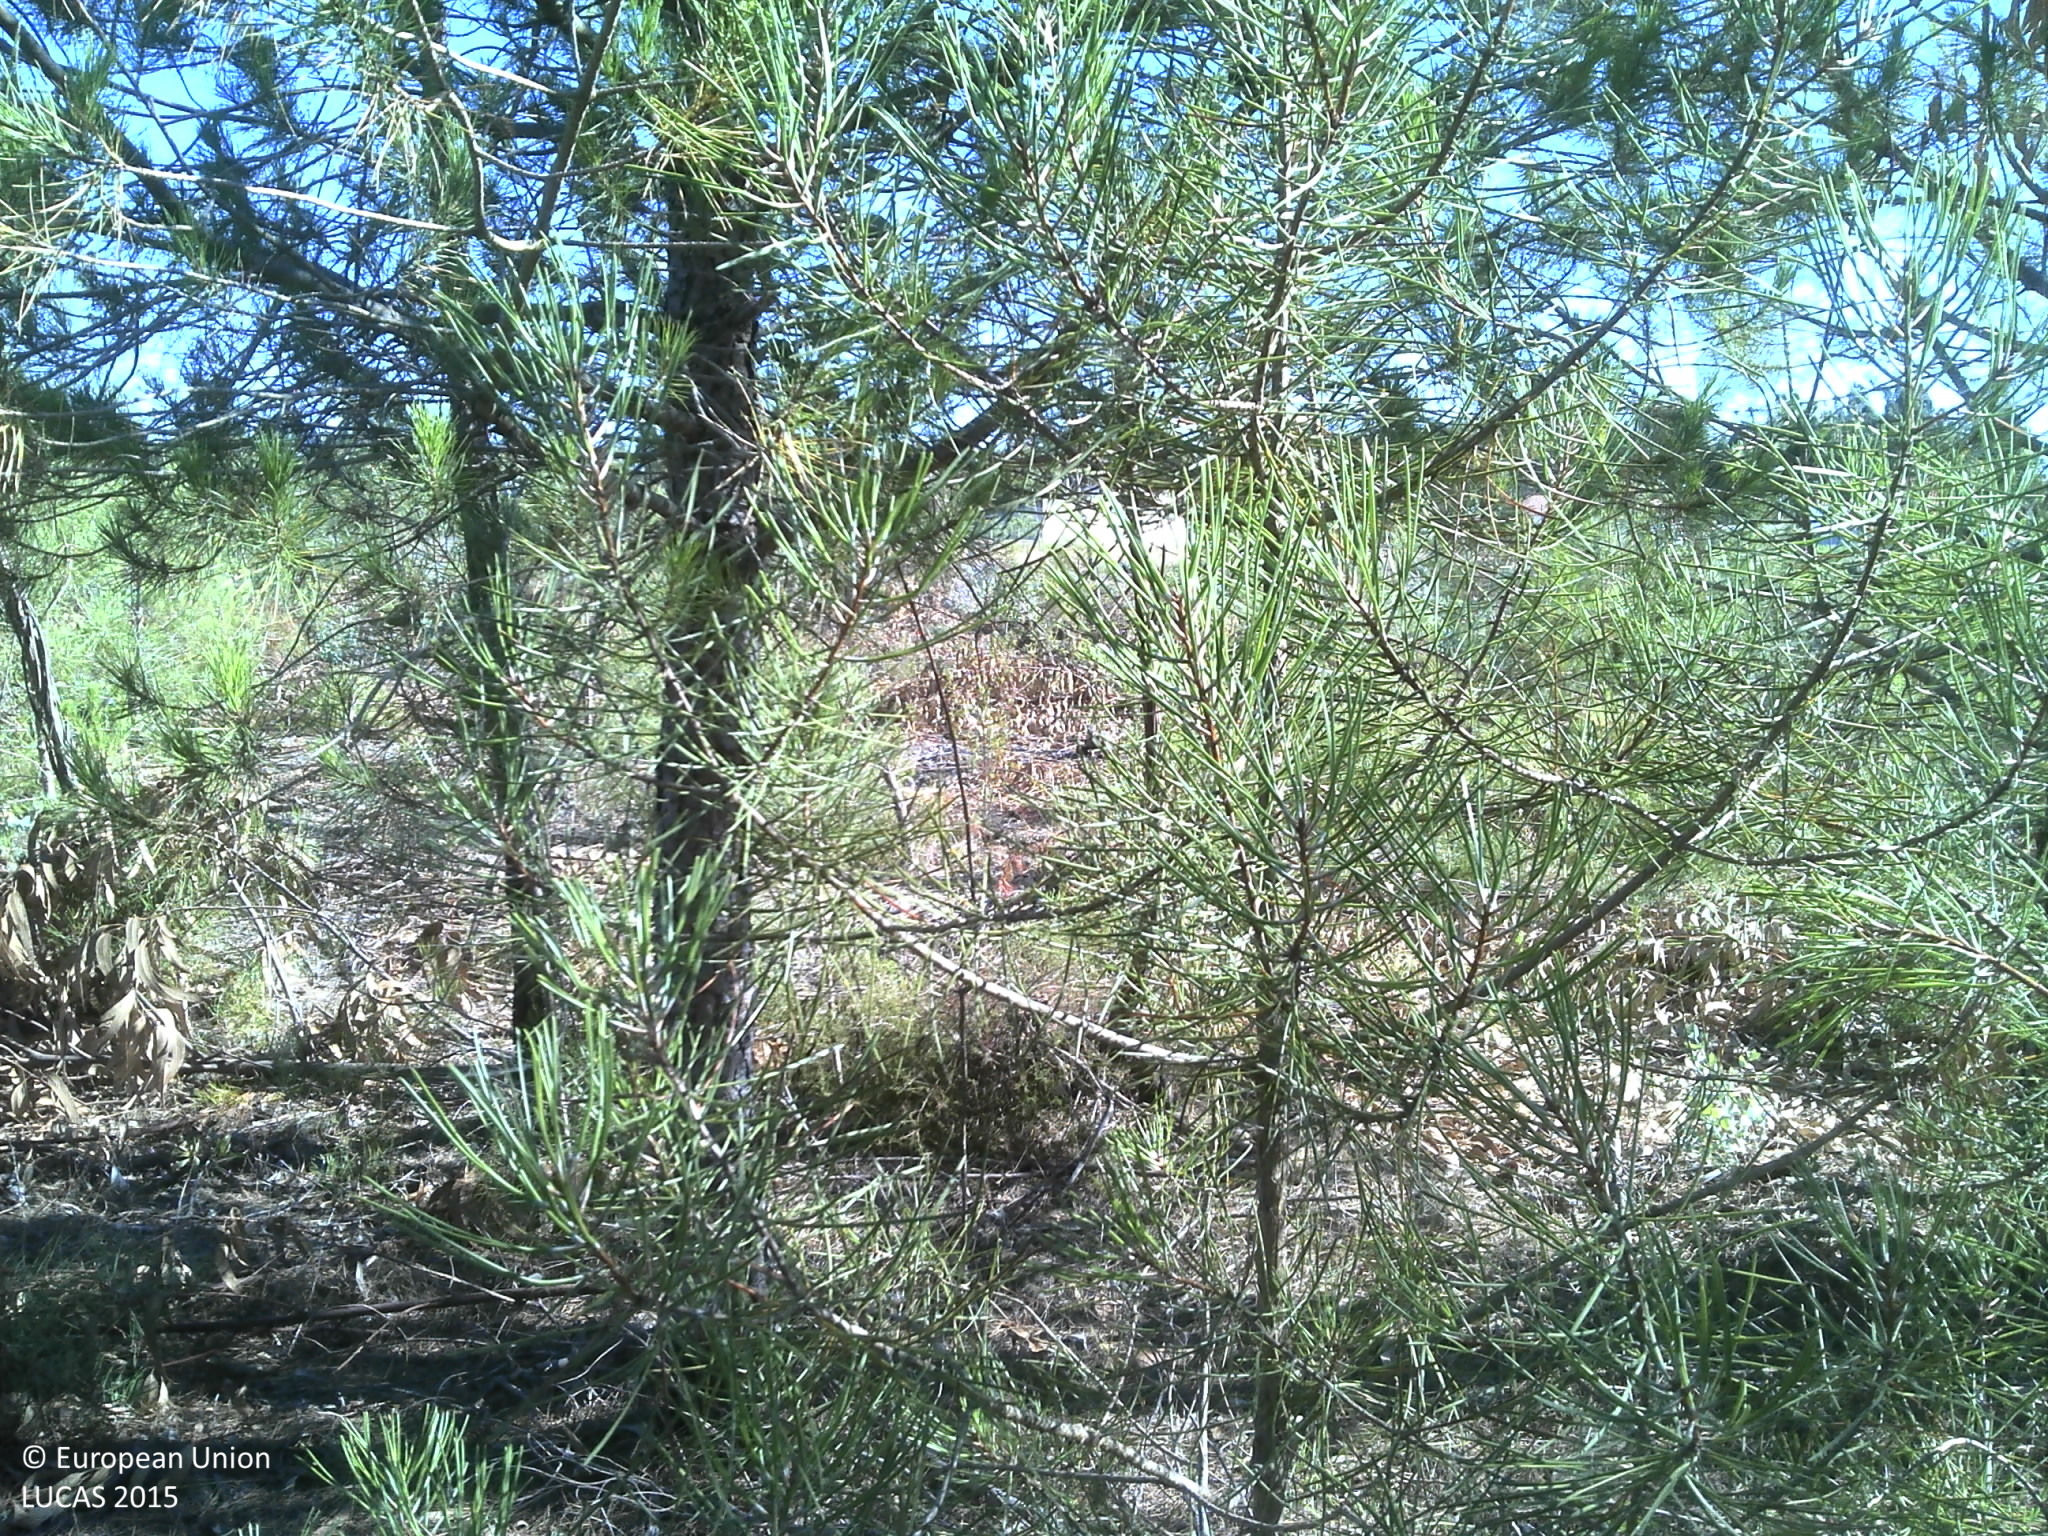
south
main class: Woodland
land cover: Pine dominated coniferous woodland
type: coniferous forest of the mediterranean region
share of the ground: 25 - 50 %
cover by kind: coniferous forest trees 50 %, unconsolidated bare surface 45 %, shrubs 5 %
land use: Forestry
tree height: < 5 m
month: July
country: PT
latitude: 39.0383
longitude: -8.6328
